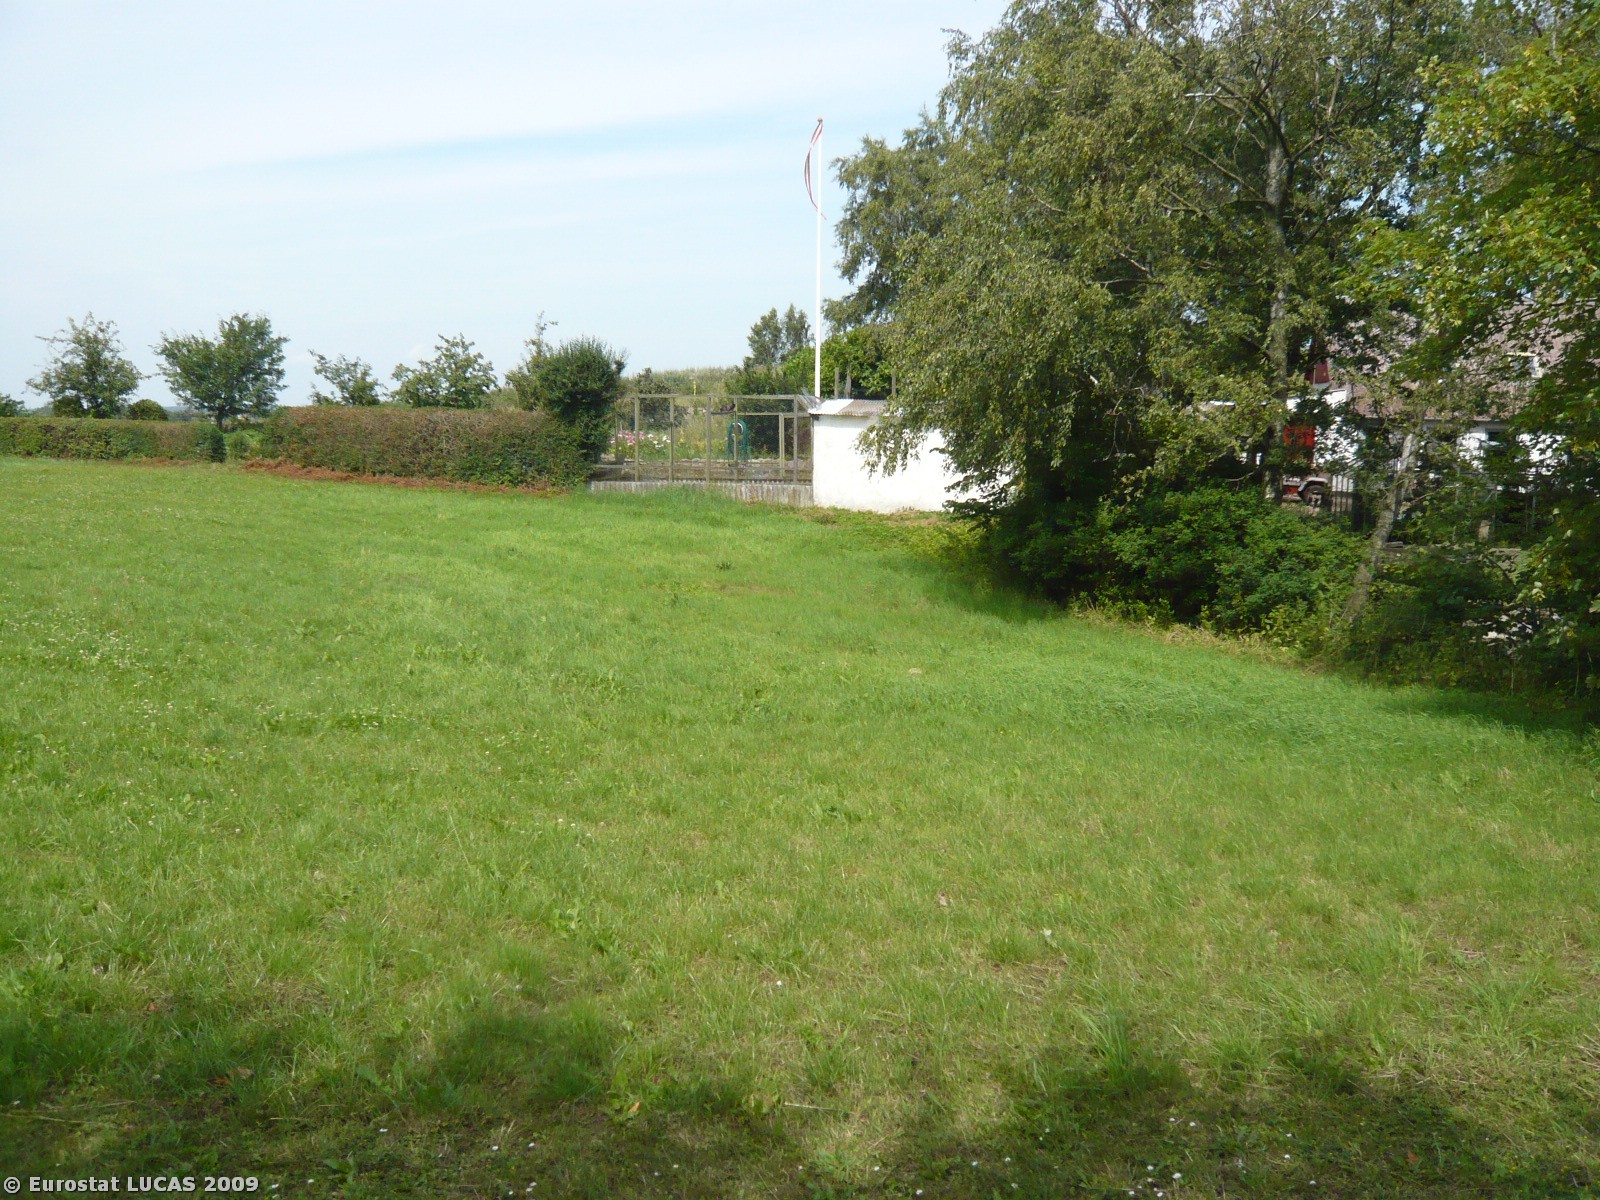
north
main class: Cropland
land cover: Common wheat
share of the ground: > 75 %
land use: Agriculture (excluding fallow land and kitchen gardens)
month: July
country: DK
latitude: 55.5640
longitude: 11.7902
